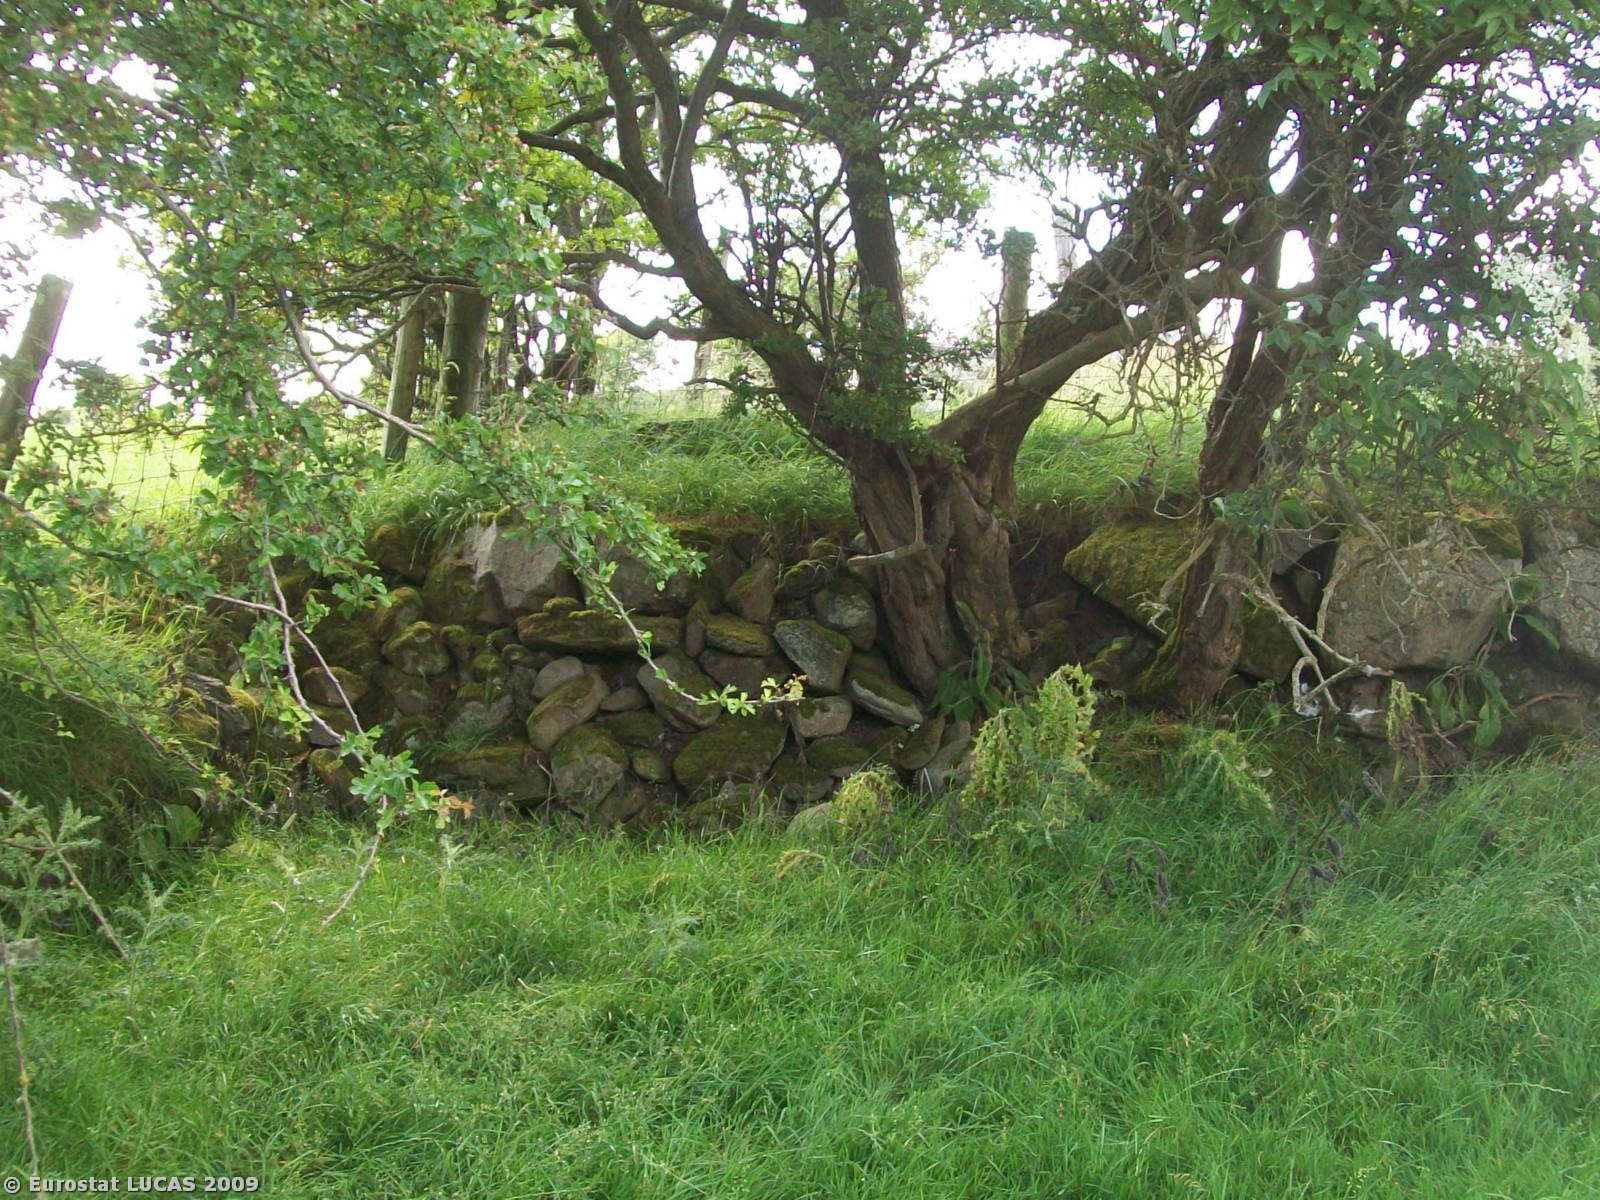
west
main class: Grassland
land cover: Grassland without tree/shrub cover
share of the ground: > 75 %
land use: Agriculture (excluding fallow land and kitchen gardens)
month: July
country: GB
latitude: 54.8724
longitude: -7.0158
